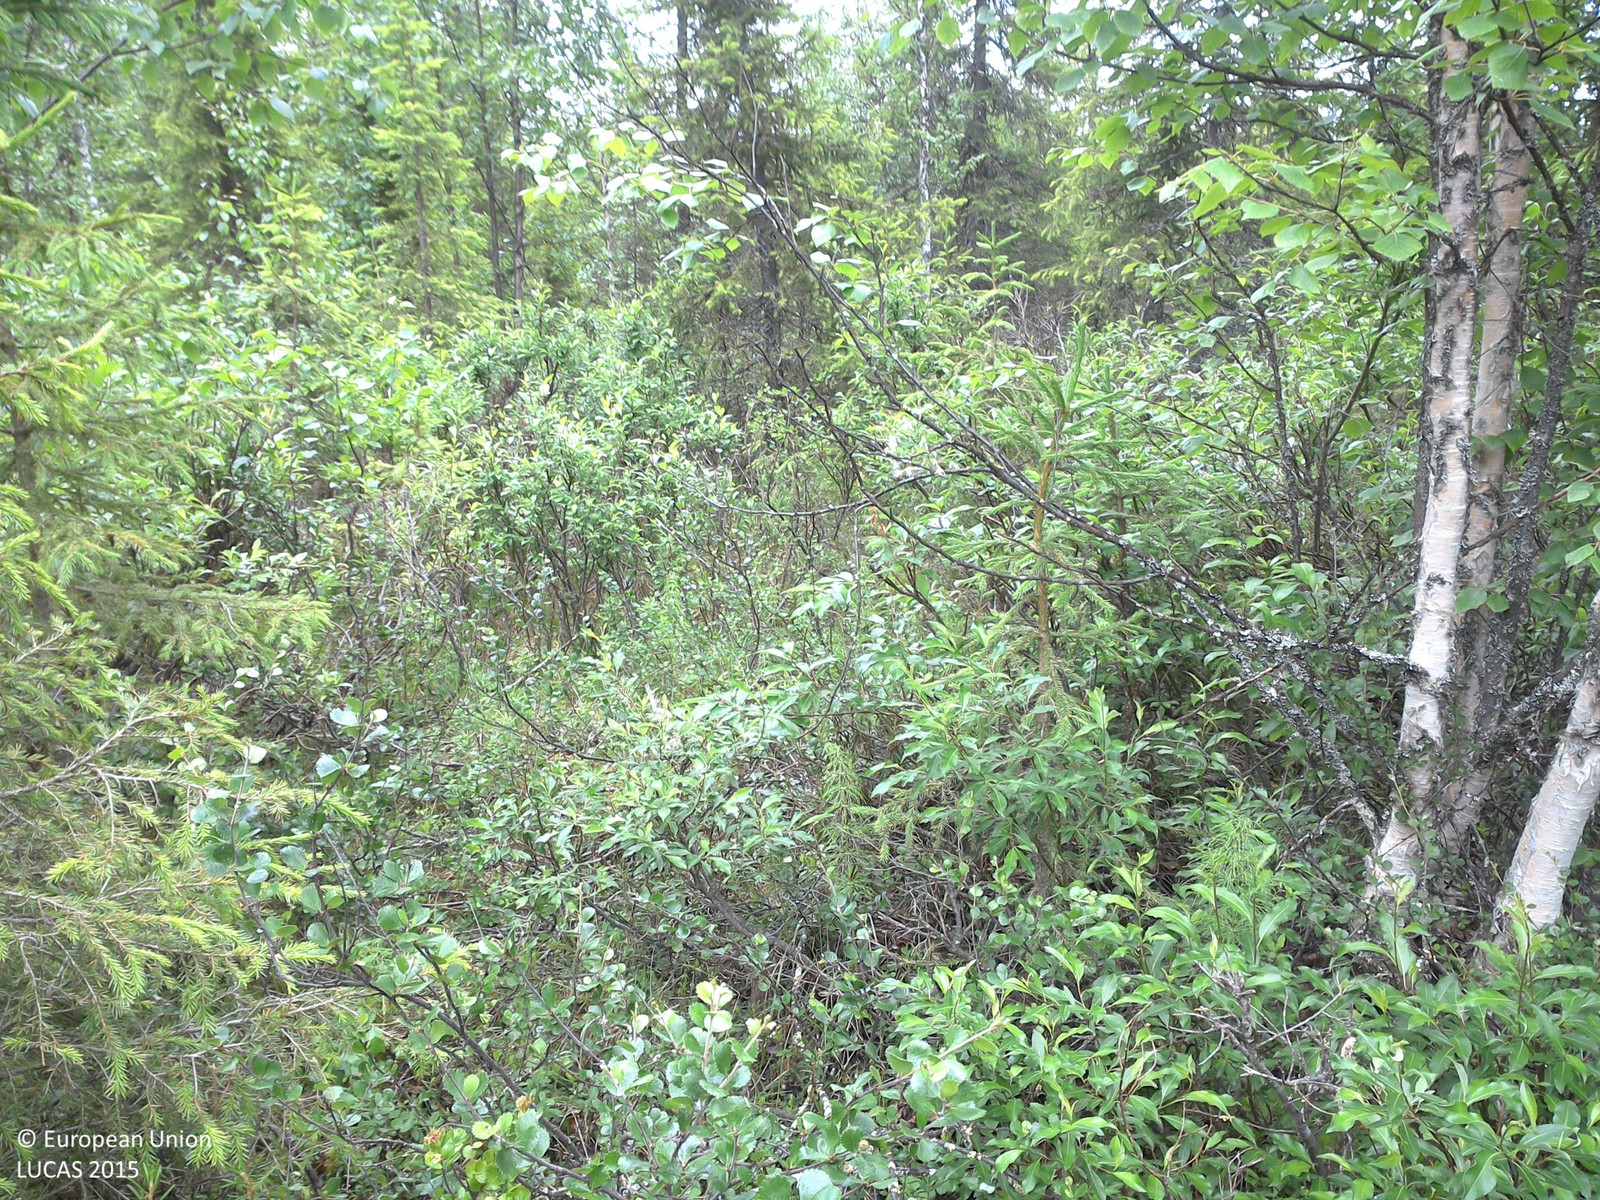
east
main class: Woodland
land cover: Other mixed woodland
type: boreal forest
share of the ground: 25 - 50 %
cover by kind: shrubs 65 %, broadleaved forest trees 20 %, coniferous forest trees 10 %, lichens and mosses 5 %
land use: Forestry
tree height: > 5 m
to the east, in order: Other mixed woodland; Spruce dominated mixed woodland; Ditches and canals; Spruce dominated mixed woodland; Broadleaved woodland
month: July
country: SE
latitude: 66.8234
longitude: 23.8972
